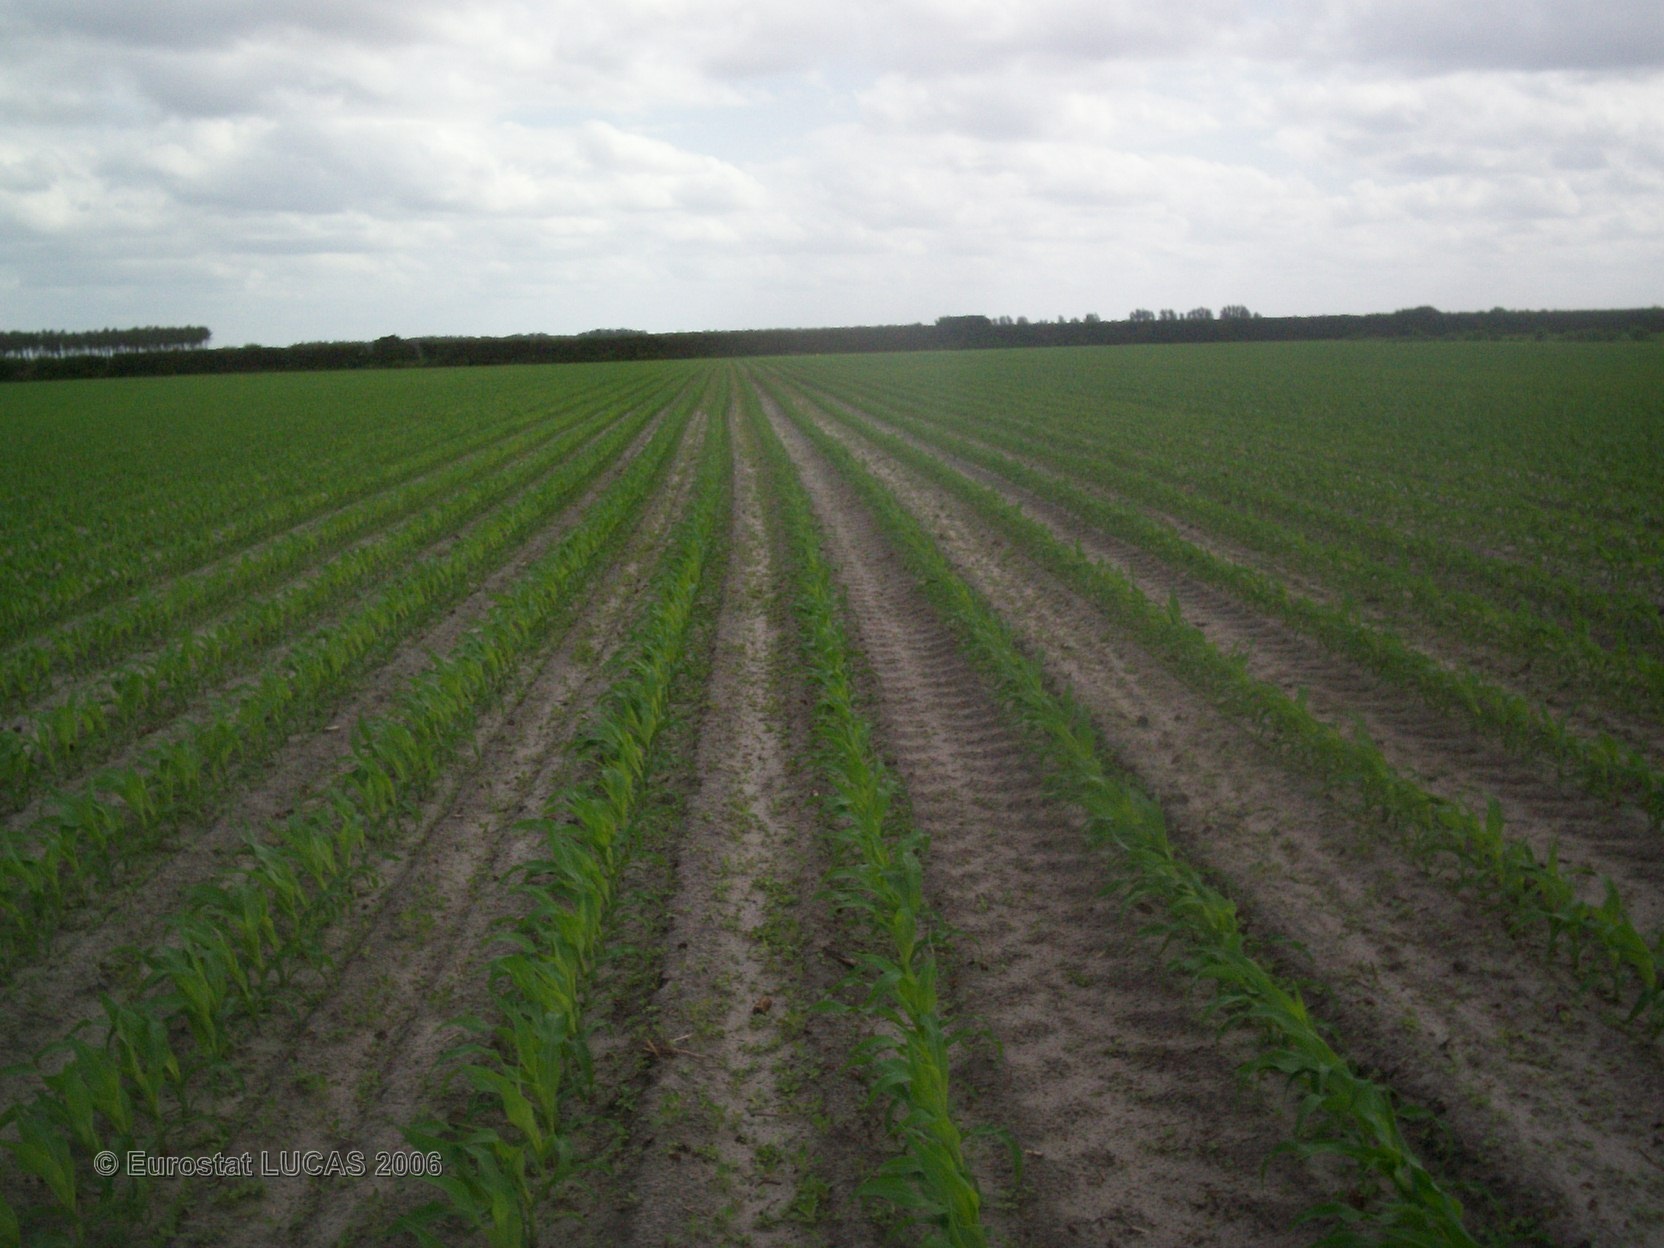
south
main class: Cropland
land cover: Maize
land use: Agriculture (excluding fallow land and kitchen gardens)
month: May
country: FR
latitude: 44.3803
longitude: -0.4953
